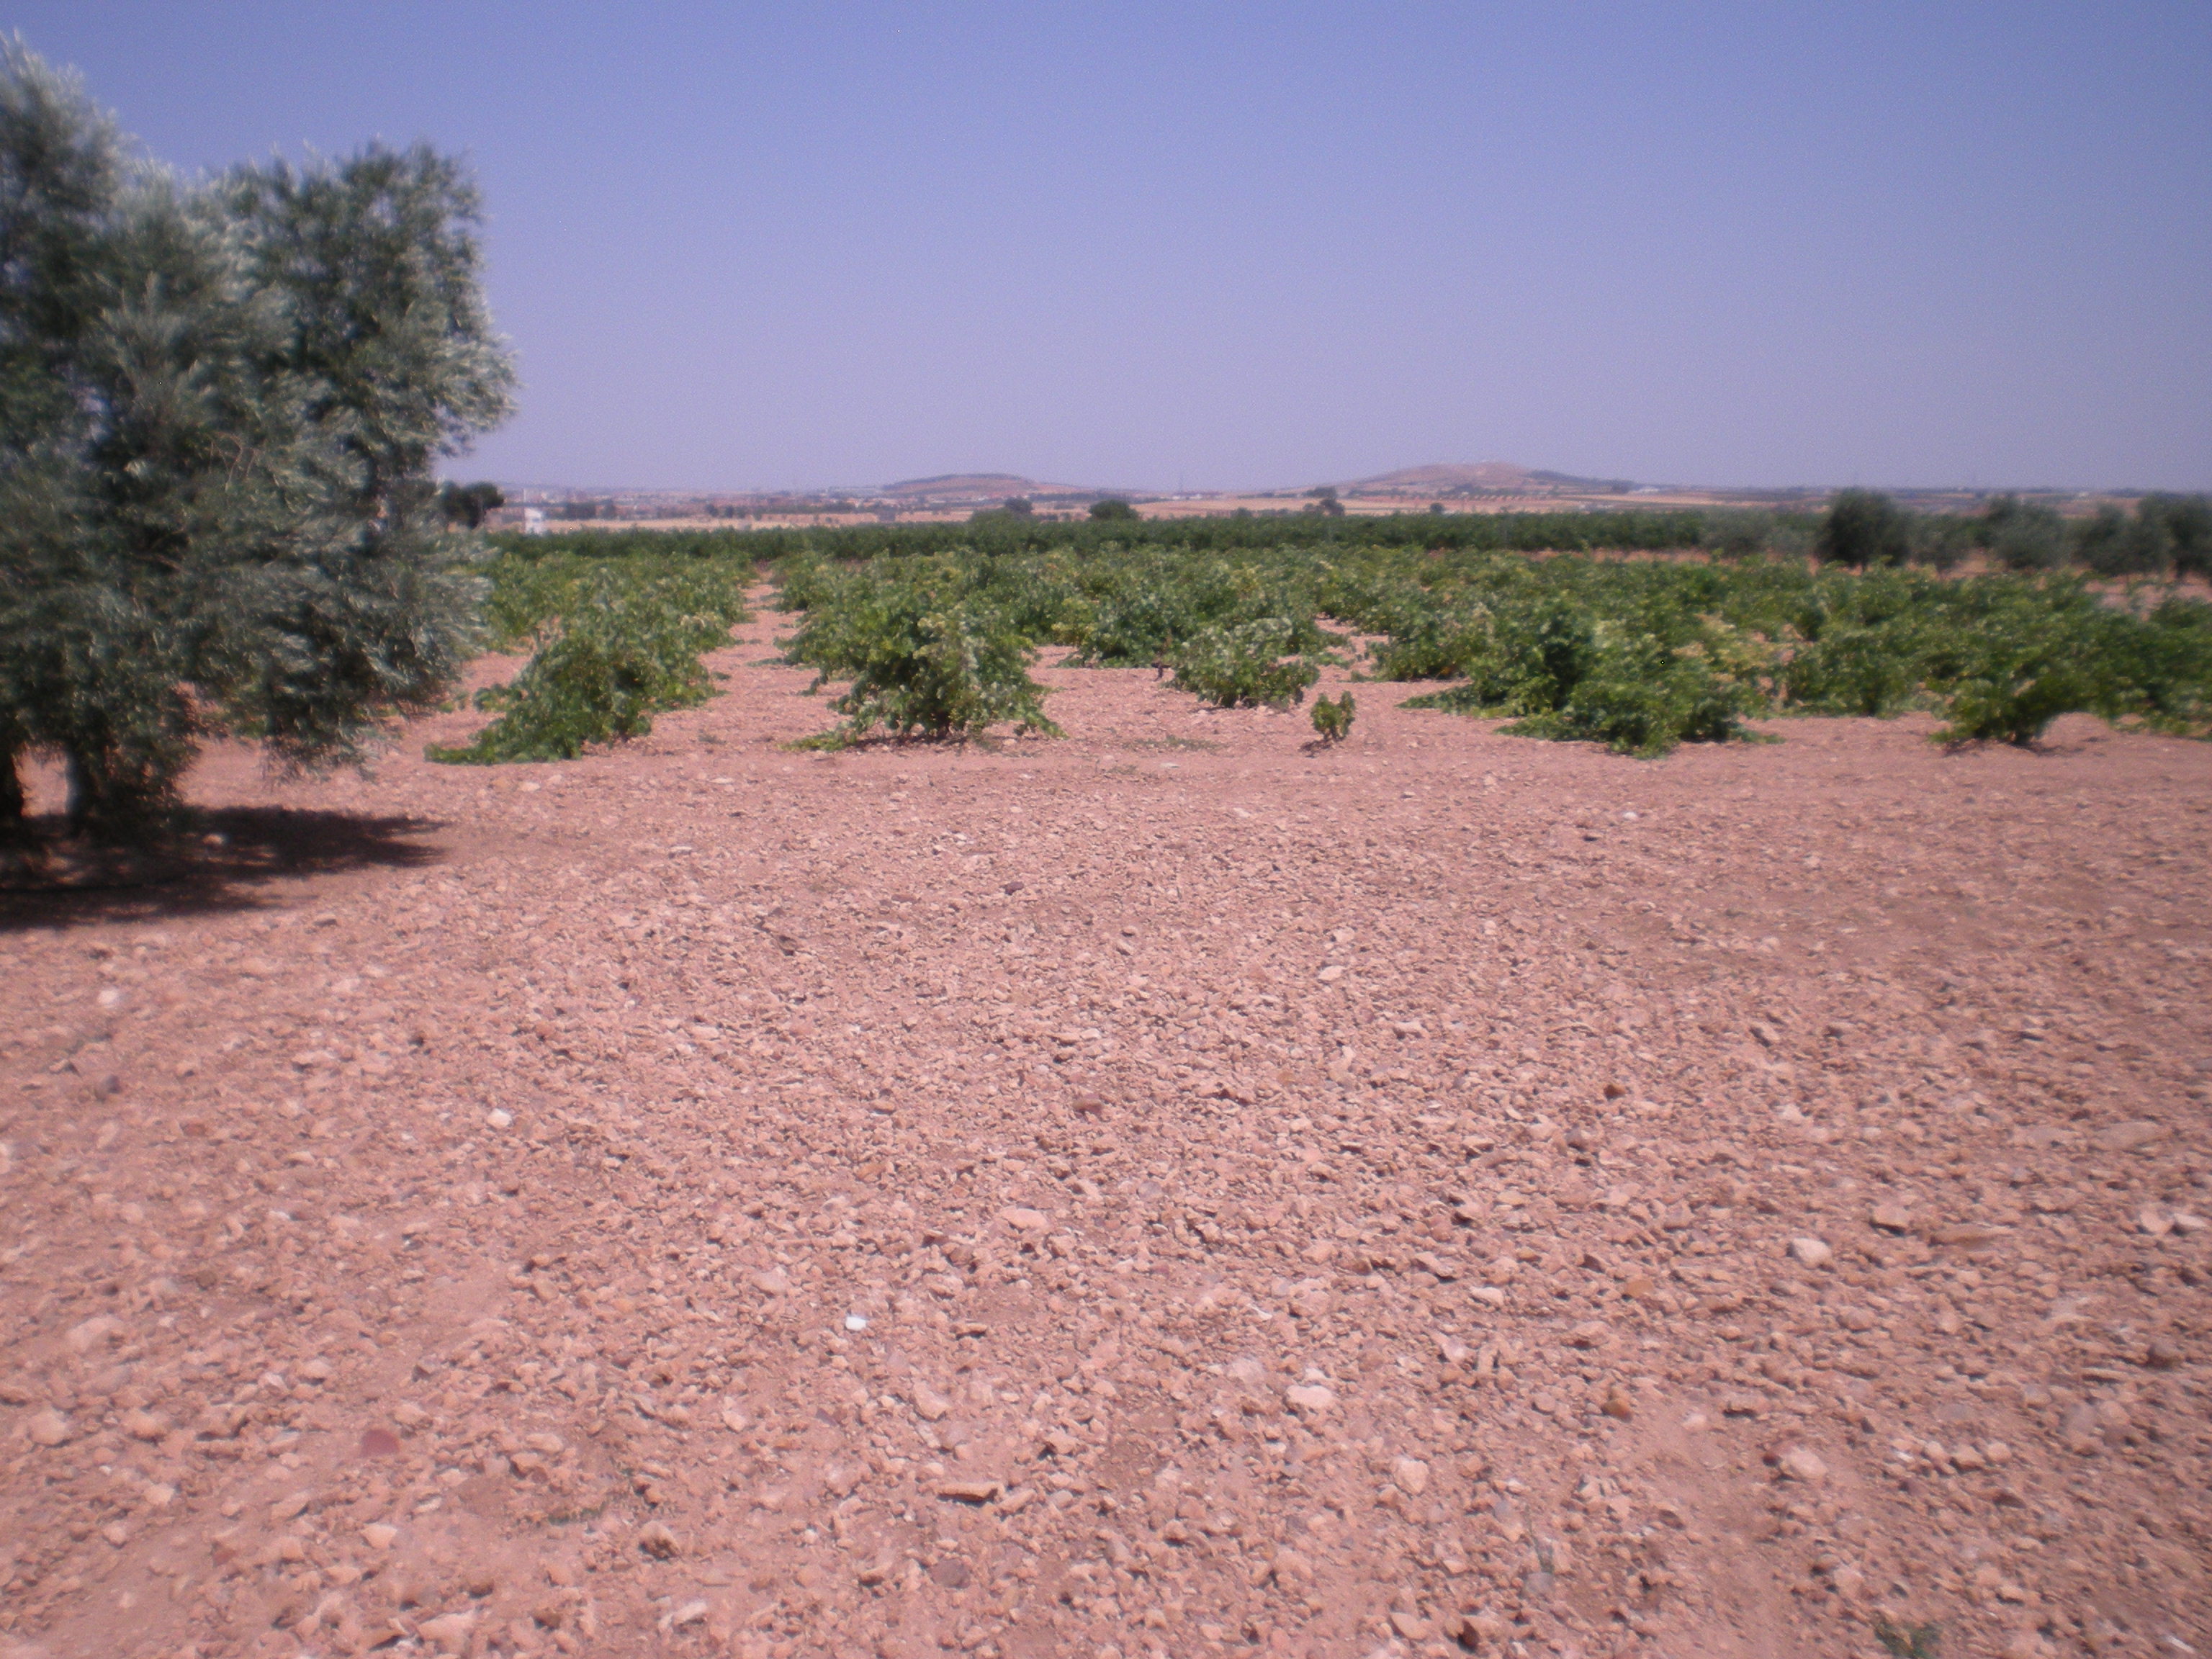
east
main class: Cropland
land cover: Olive groves
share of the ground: 10 - 25 %
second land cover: Other bare soil
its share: > 75 %
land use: Agriculture (excluding fallow land and kitchen gardens)
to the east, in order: Olive groves; Other bare soil; Vineyards; Grass margins; Tracks; Grass margins; Vineyards
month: July
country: ES
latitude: 39.3806
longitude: -3.2643
